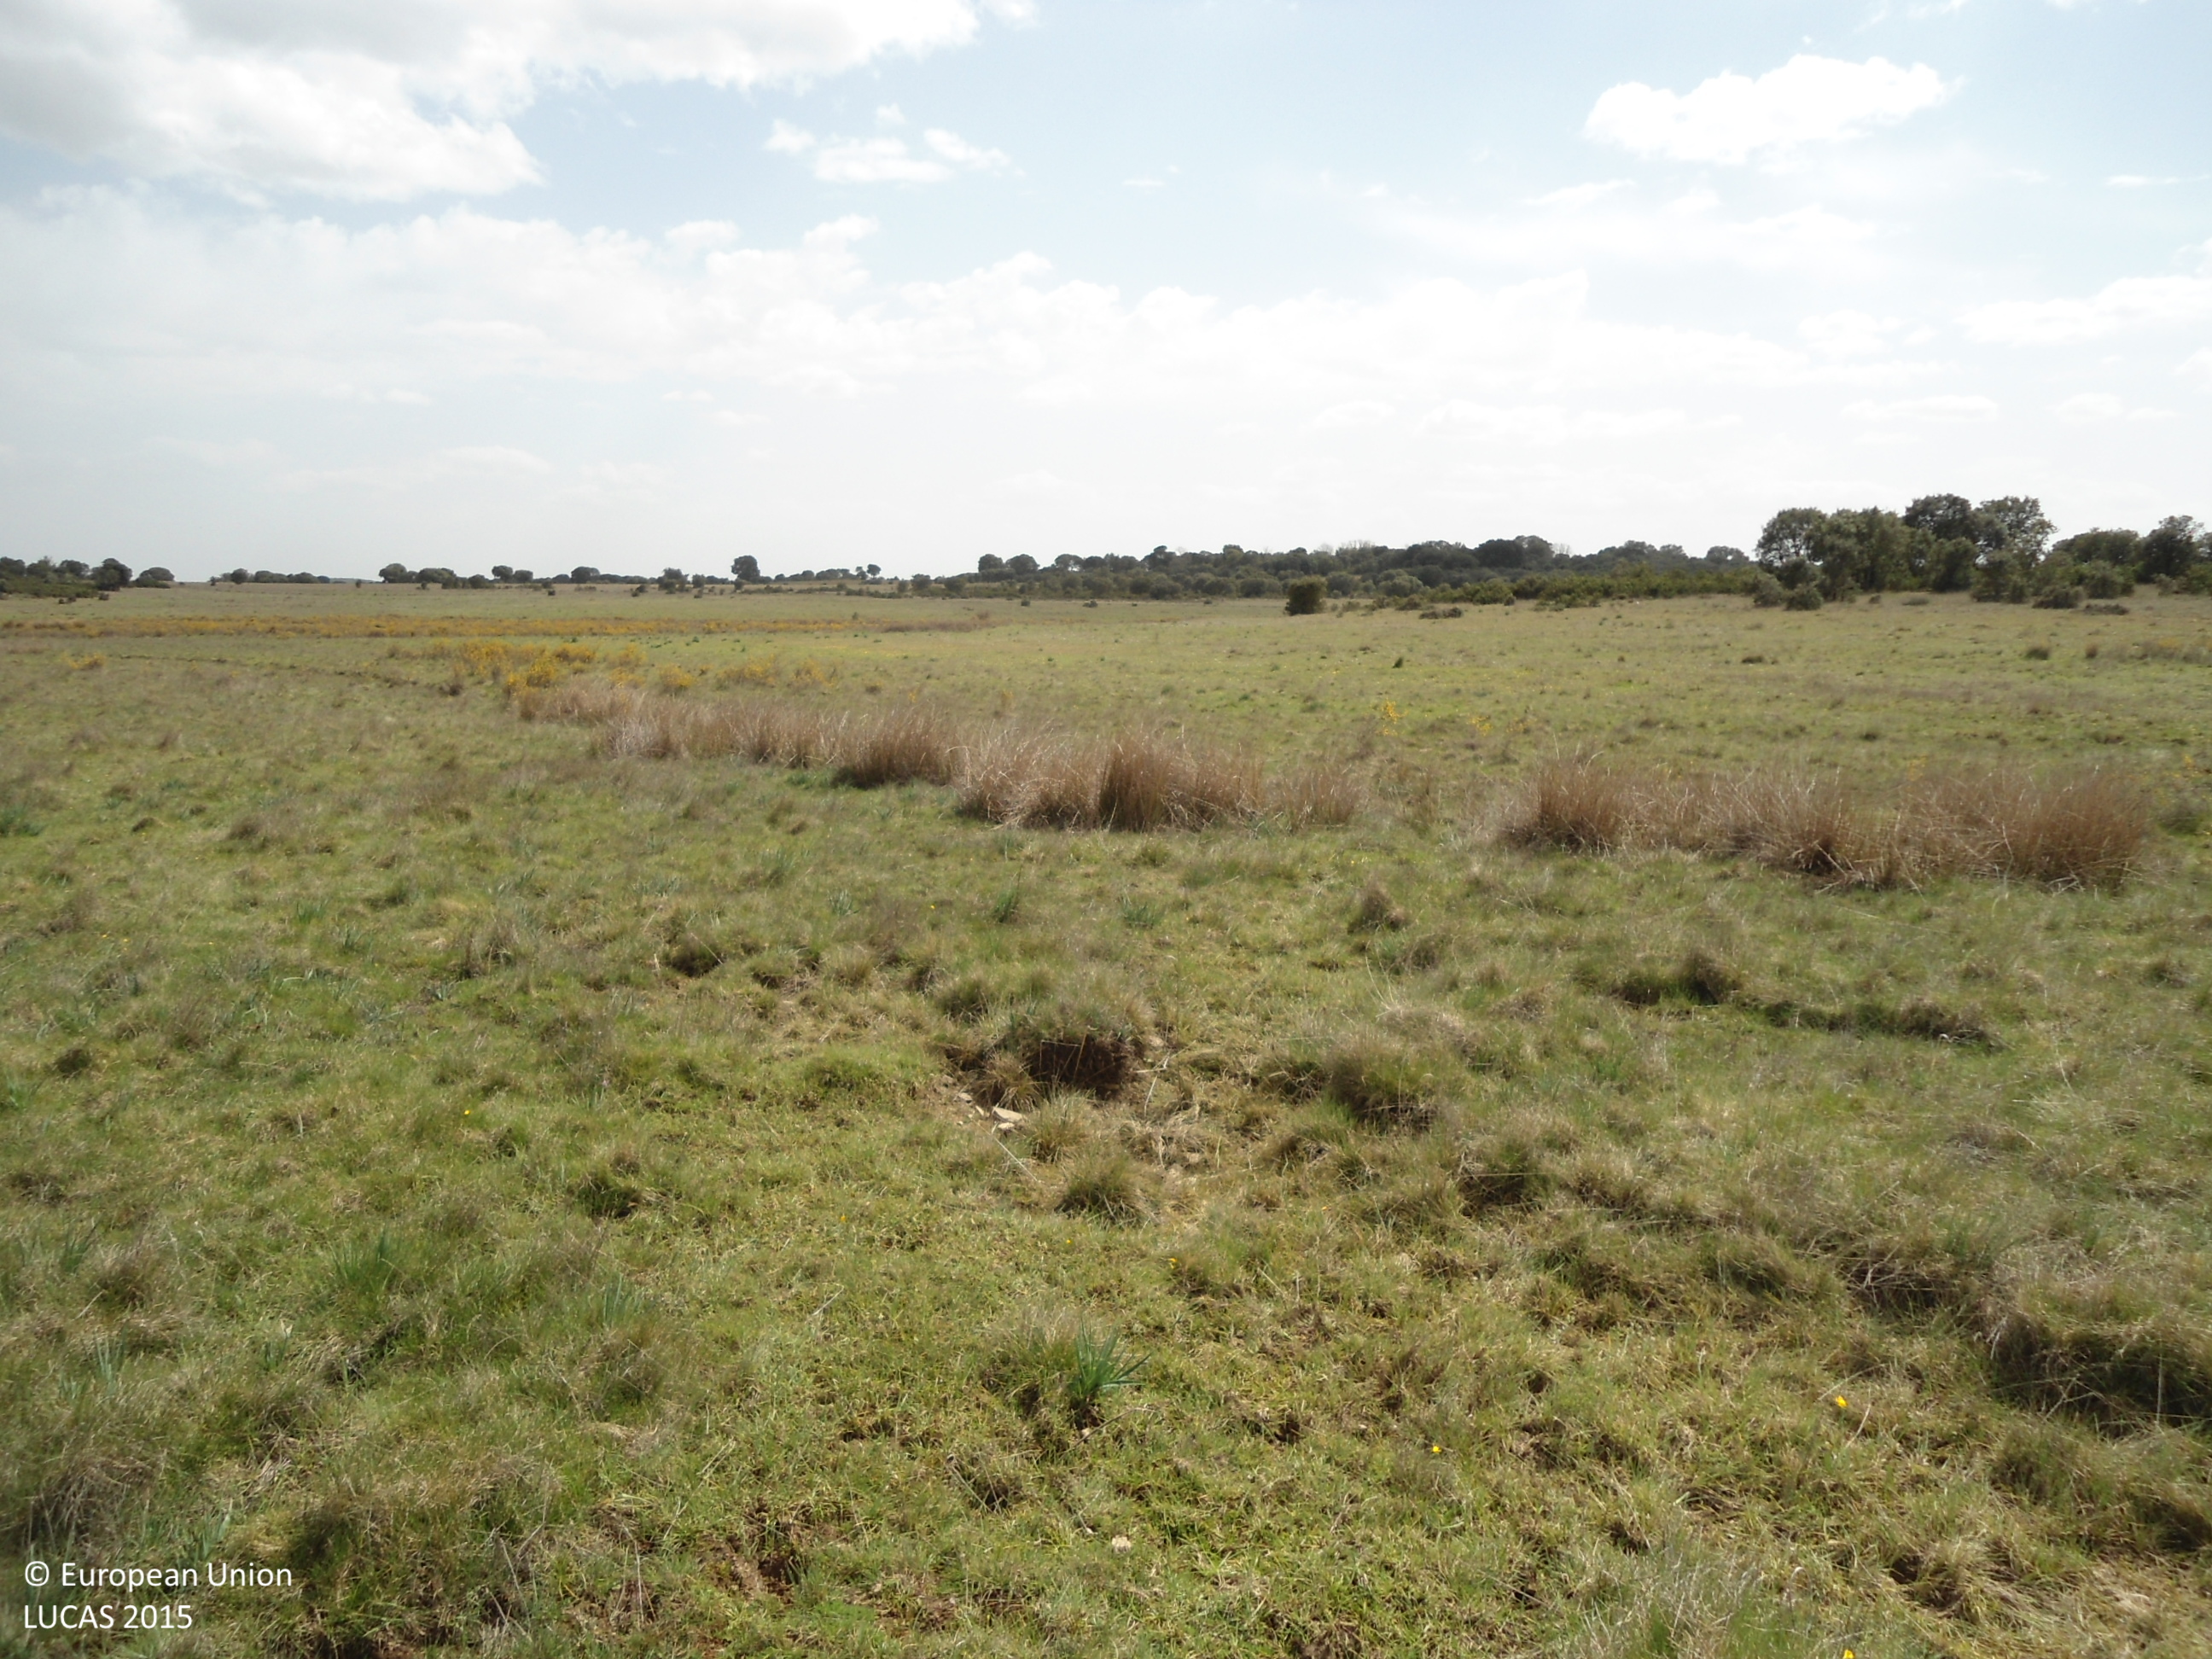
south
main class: Grassland
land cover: Grassland without tree/shrub cover
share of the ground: > 75 %
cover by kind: herbaceous plants 100 %
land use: Agriculture (excluding fallow land and kitchen gardens)
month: April
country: ES
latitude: 41.7814
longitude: -6.3091
